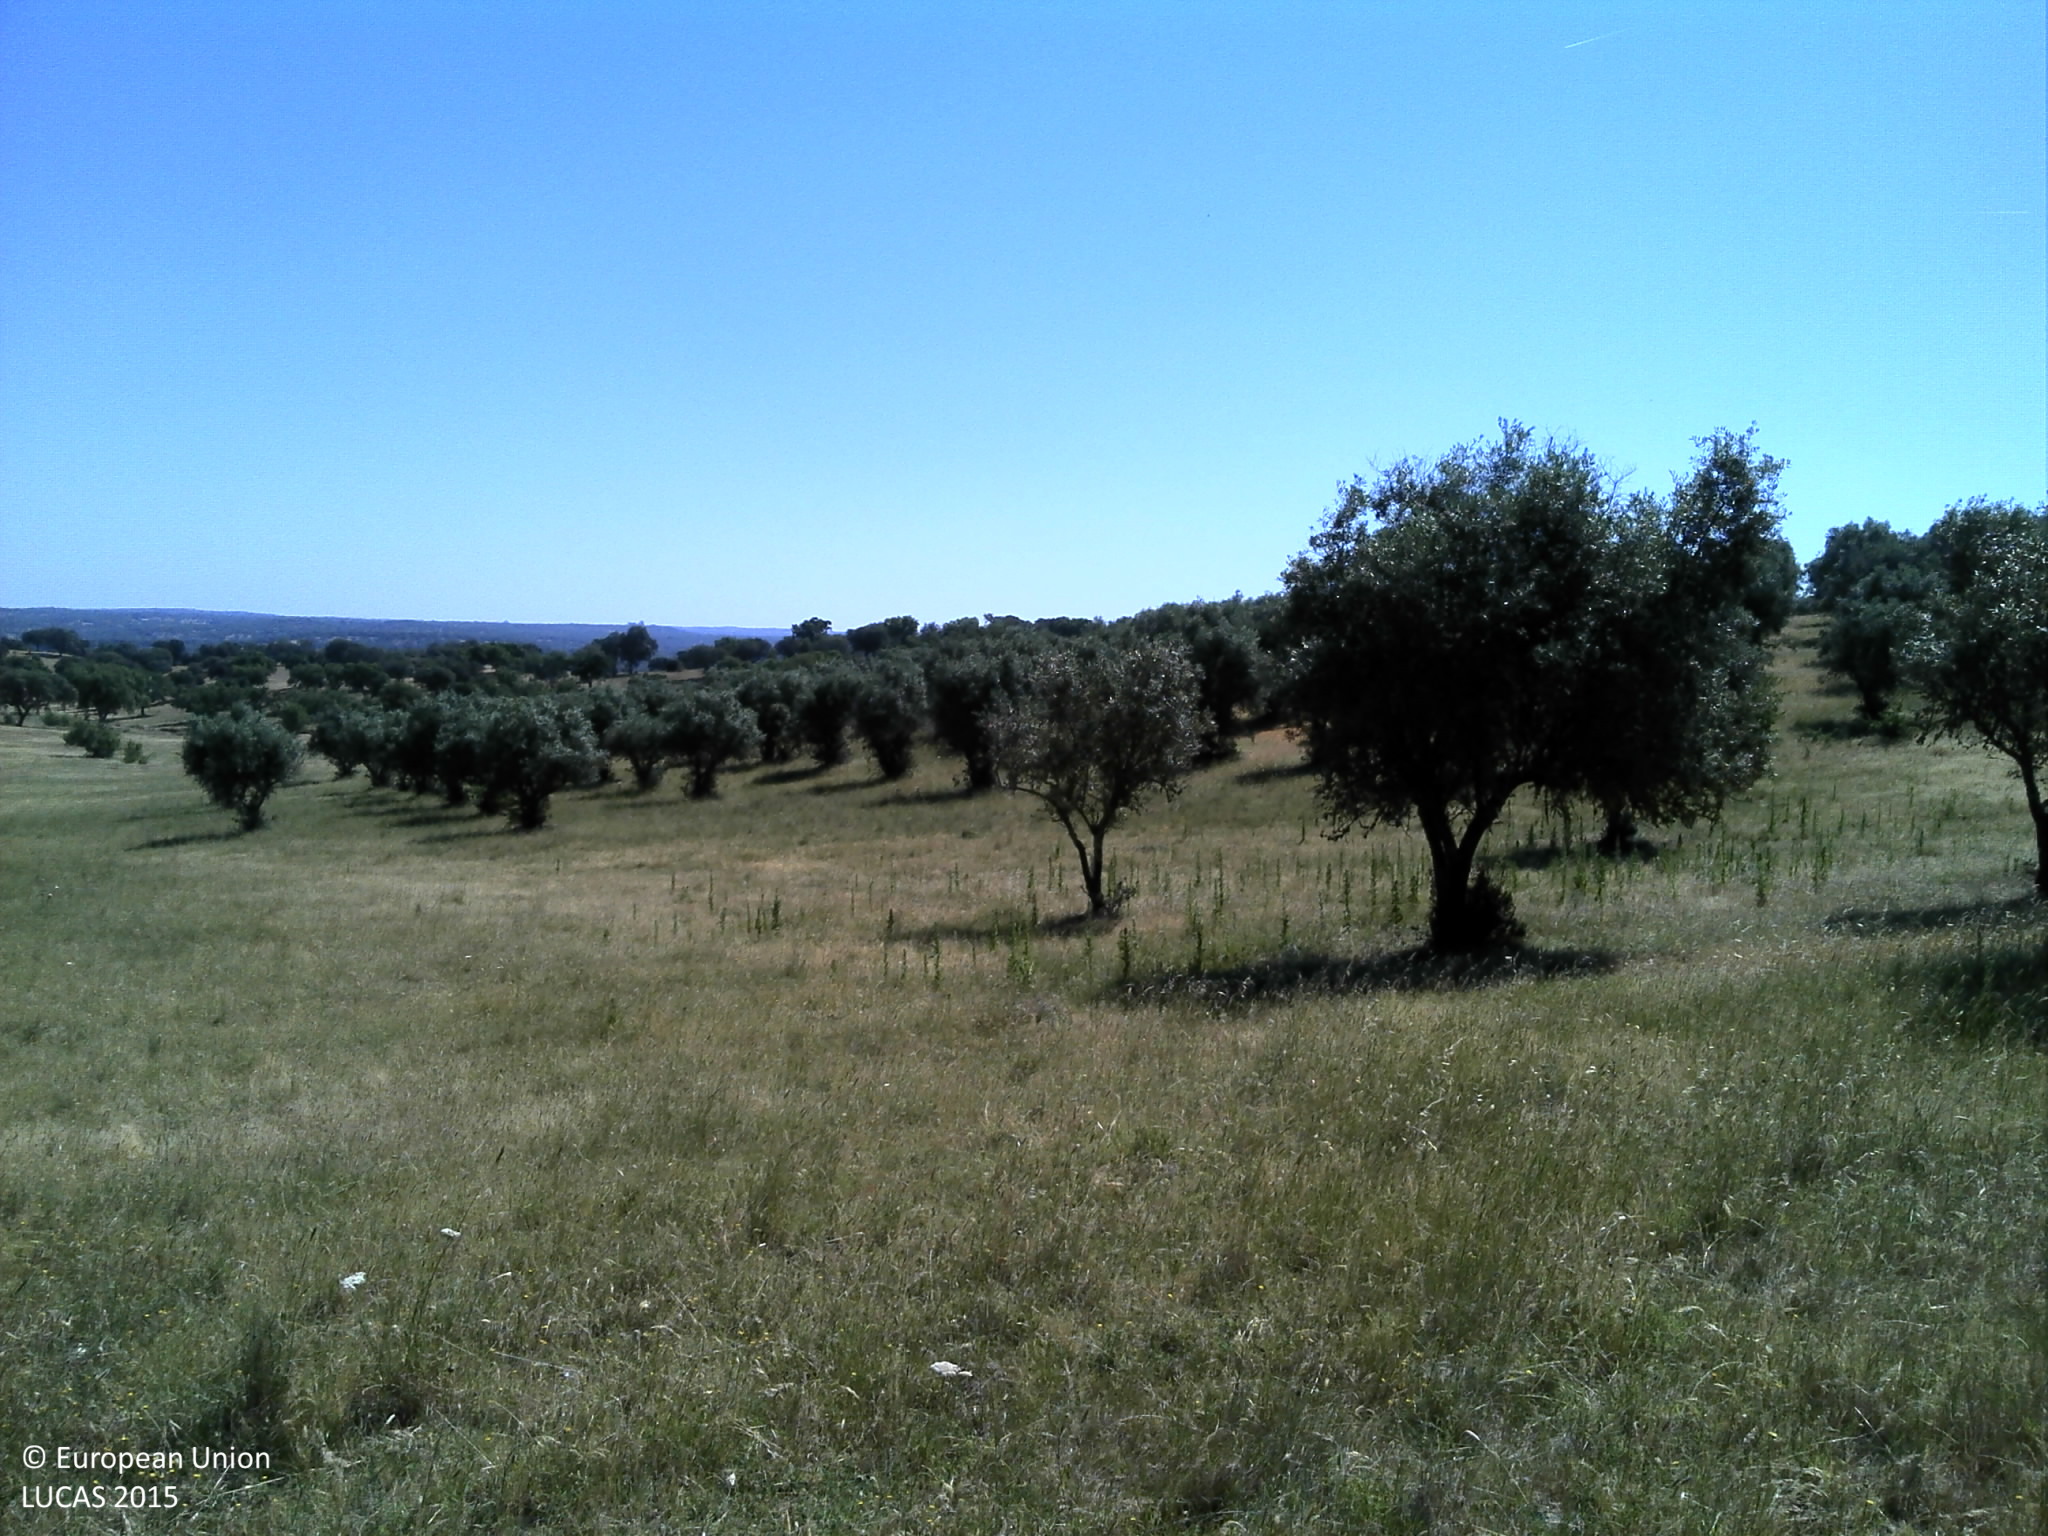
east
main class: Grassland
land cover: Grassland without tree/shrub cover
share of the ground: 50 - 75 %
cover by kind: herbaceous plants 75 %, unconsolidated bare surface 25 %
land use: Agriculture (excluding fallow land and kitchen gardens)
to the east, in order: Grassland without tree/shrub cover; Olive groves; Grassland with sparse tree/shrub cover
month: May
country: PT
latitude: 38.8578
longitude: -8.1311
